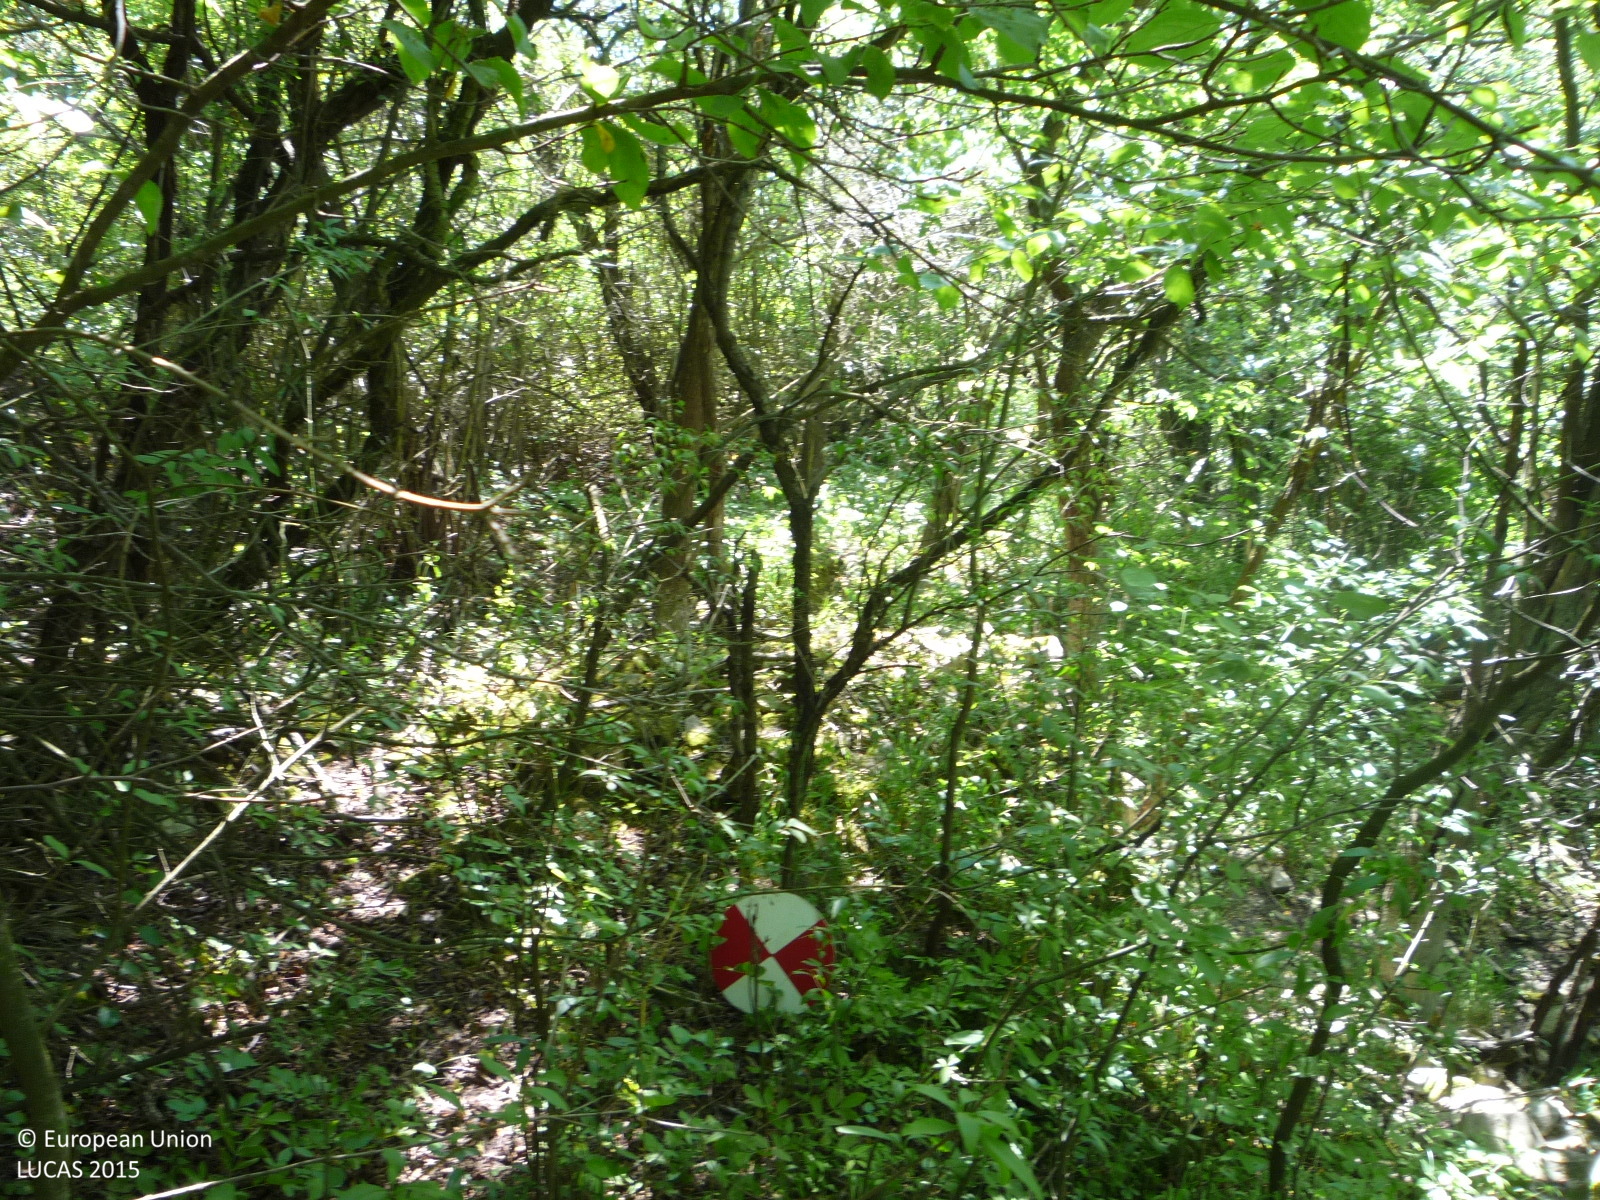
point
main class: Cropland
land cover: Other fruit trees and berries
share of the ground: > 75 %
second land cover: Spontaneously vegetated surfaces
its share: 10 - 25 %
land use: Abandoned areas
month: July
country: CZ
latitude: 50.4031
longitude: 14.4617
